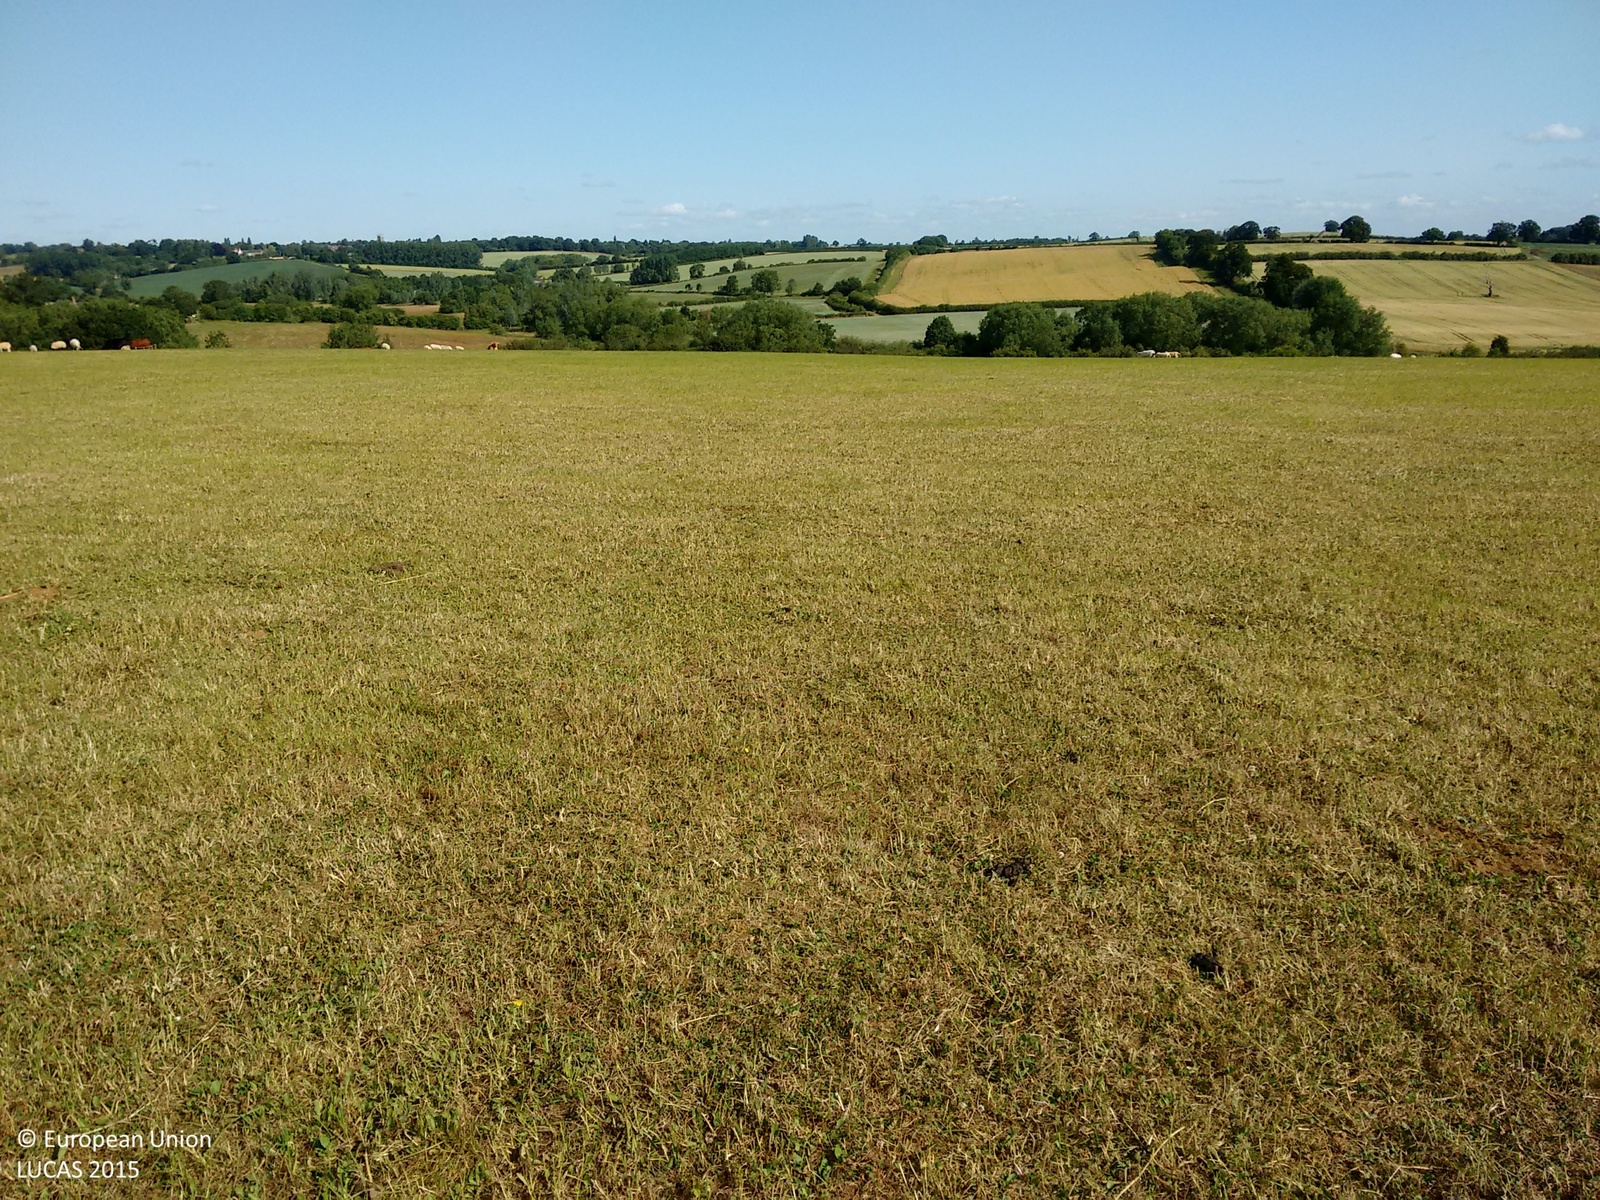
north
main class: Grassland
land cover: Grassland without tree/shrub cover
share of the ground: > 75 %
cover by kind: herbaceous plants 100 %
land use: Agriculture (excluding fallow land and kitchen gardens)
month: July
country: GB
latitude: 51.9632
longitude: -1.2985
